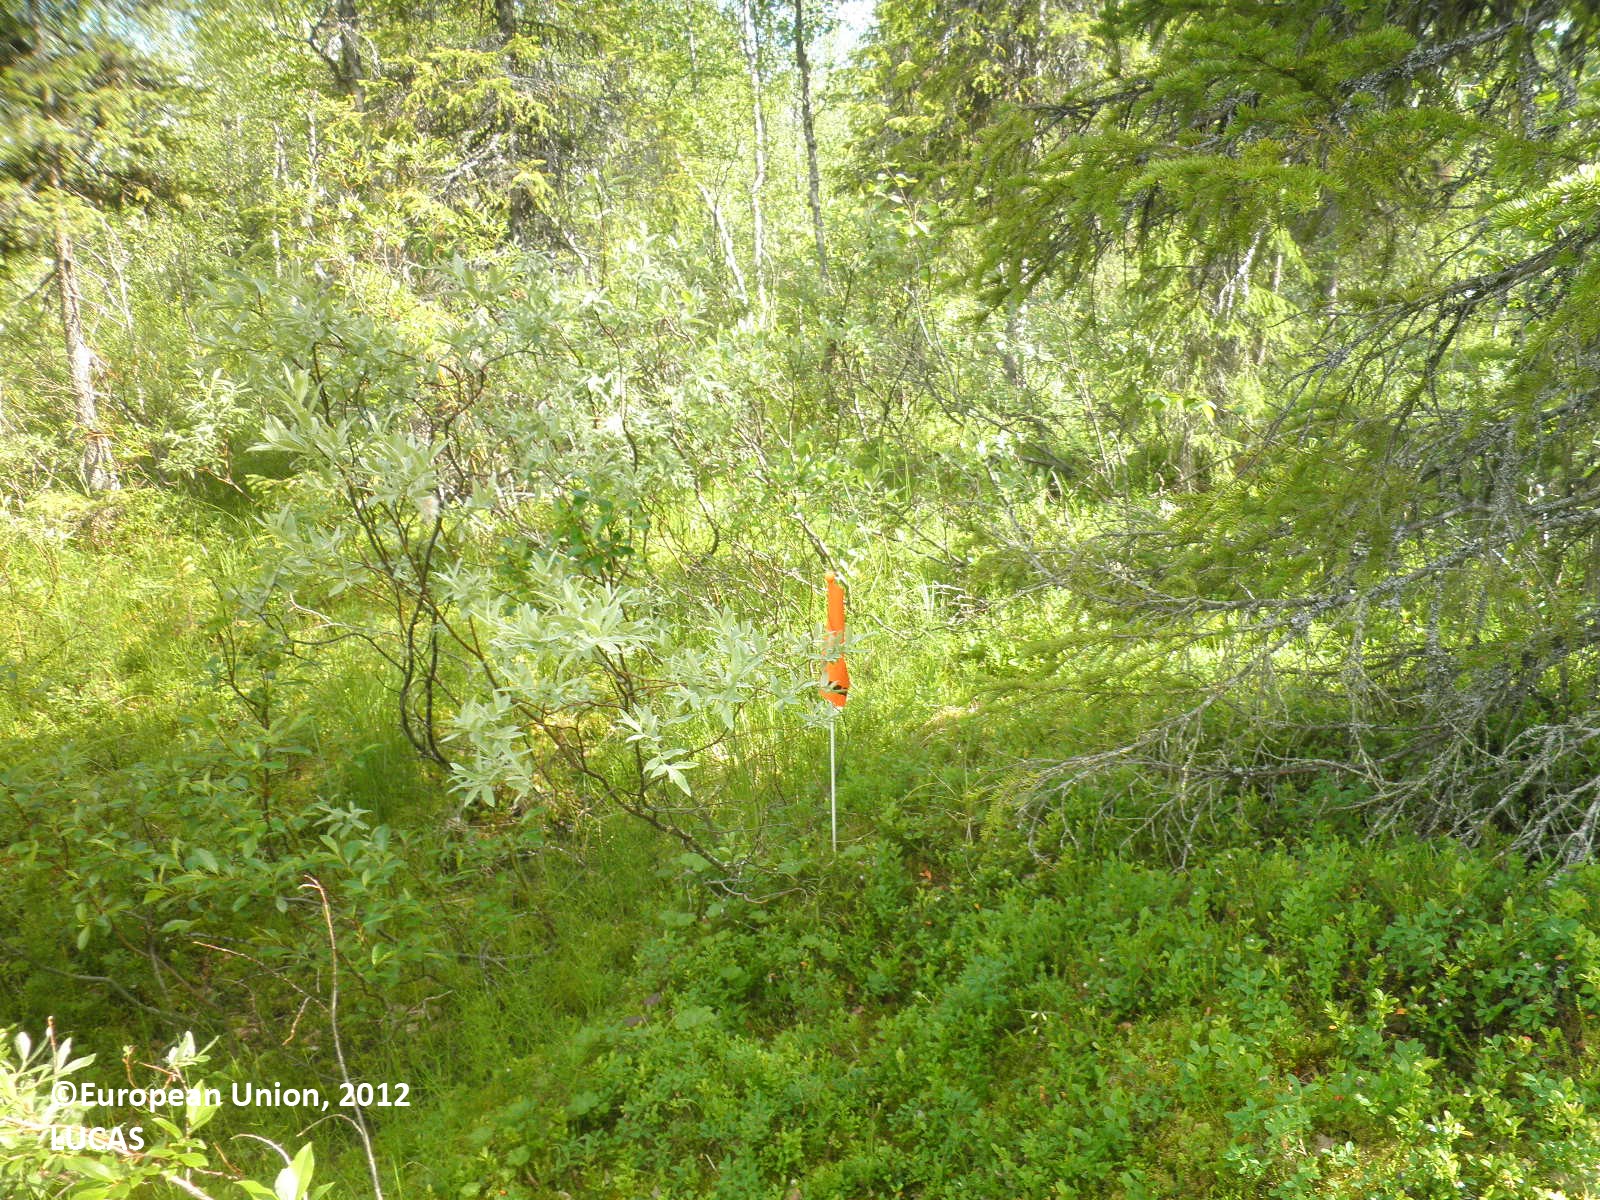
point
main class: Woodland
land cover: Spruce dominated mixed woodland
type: boreal forest
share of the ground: 50 - 75 %
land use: Forestry
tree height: > 5 m
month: July
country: FI
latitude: 67.6191
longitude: 25.8460
